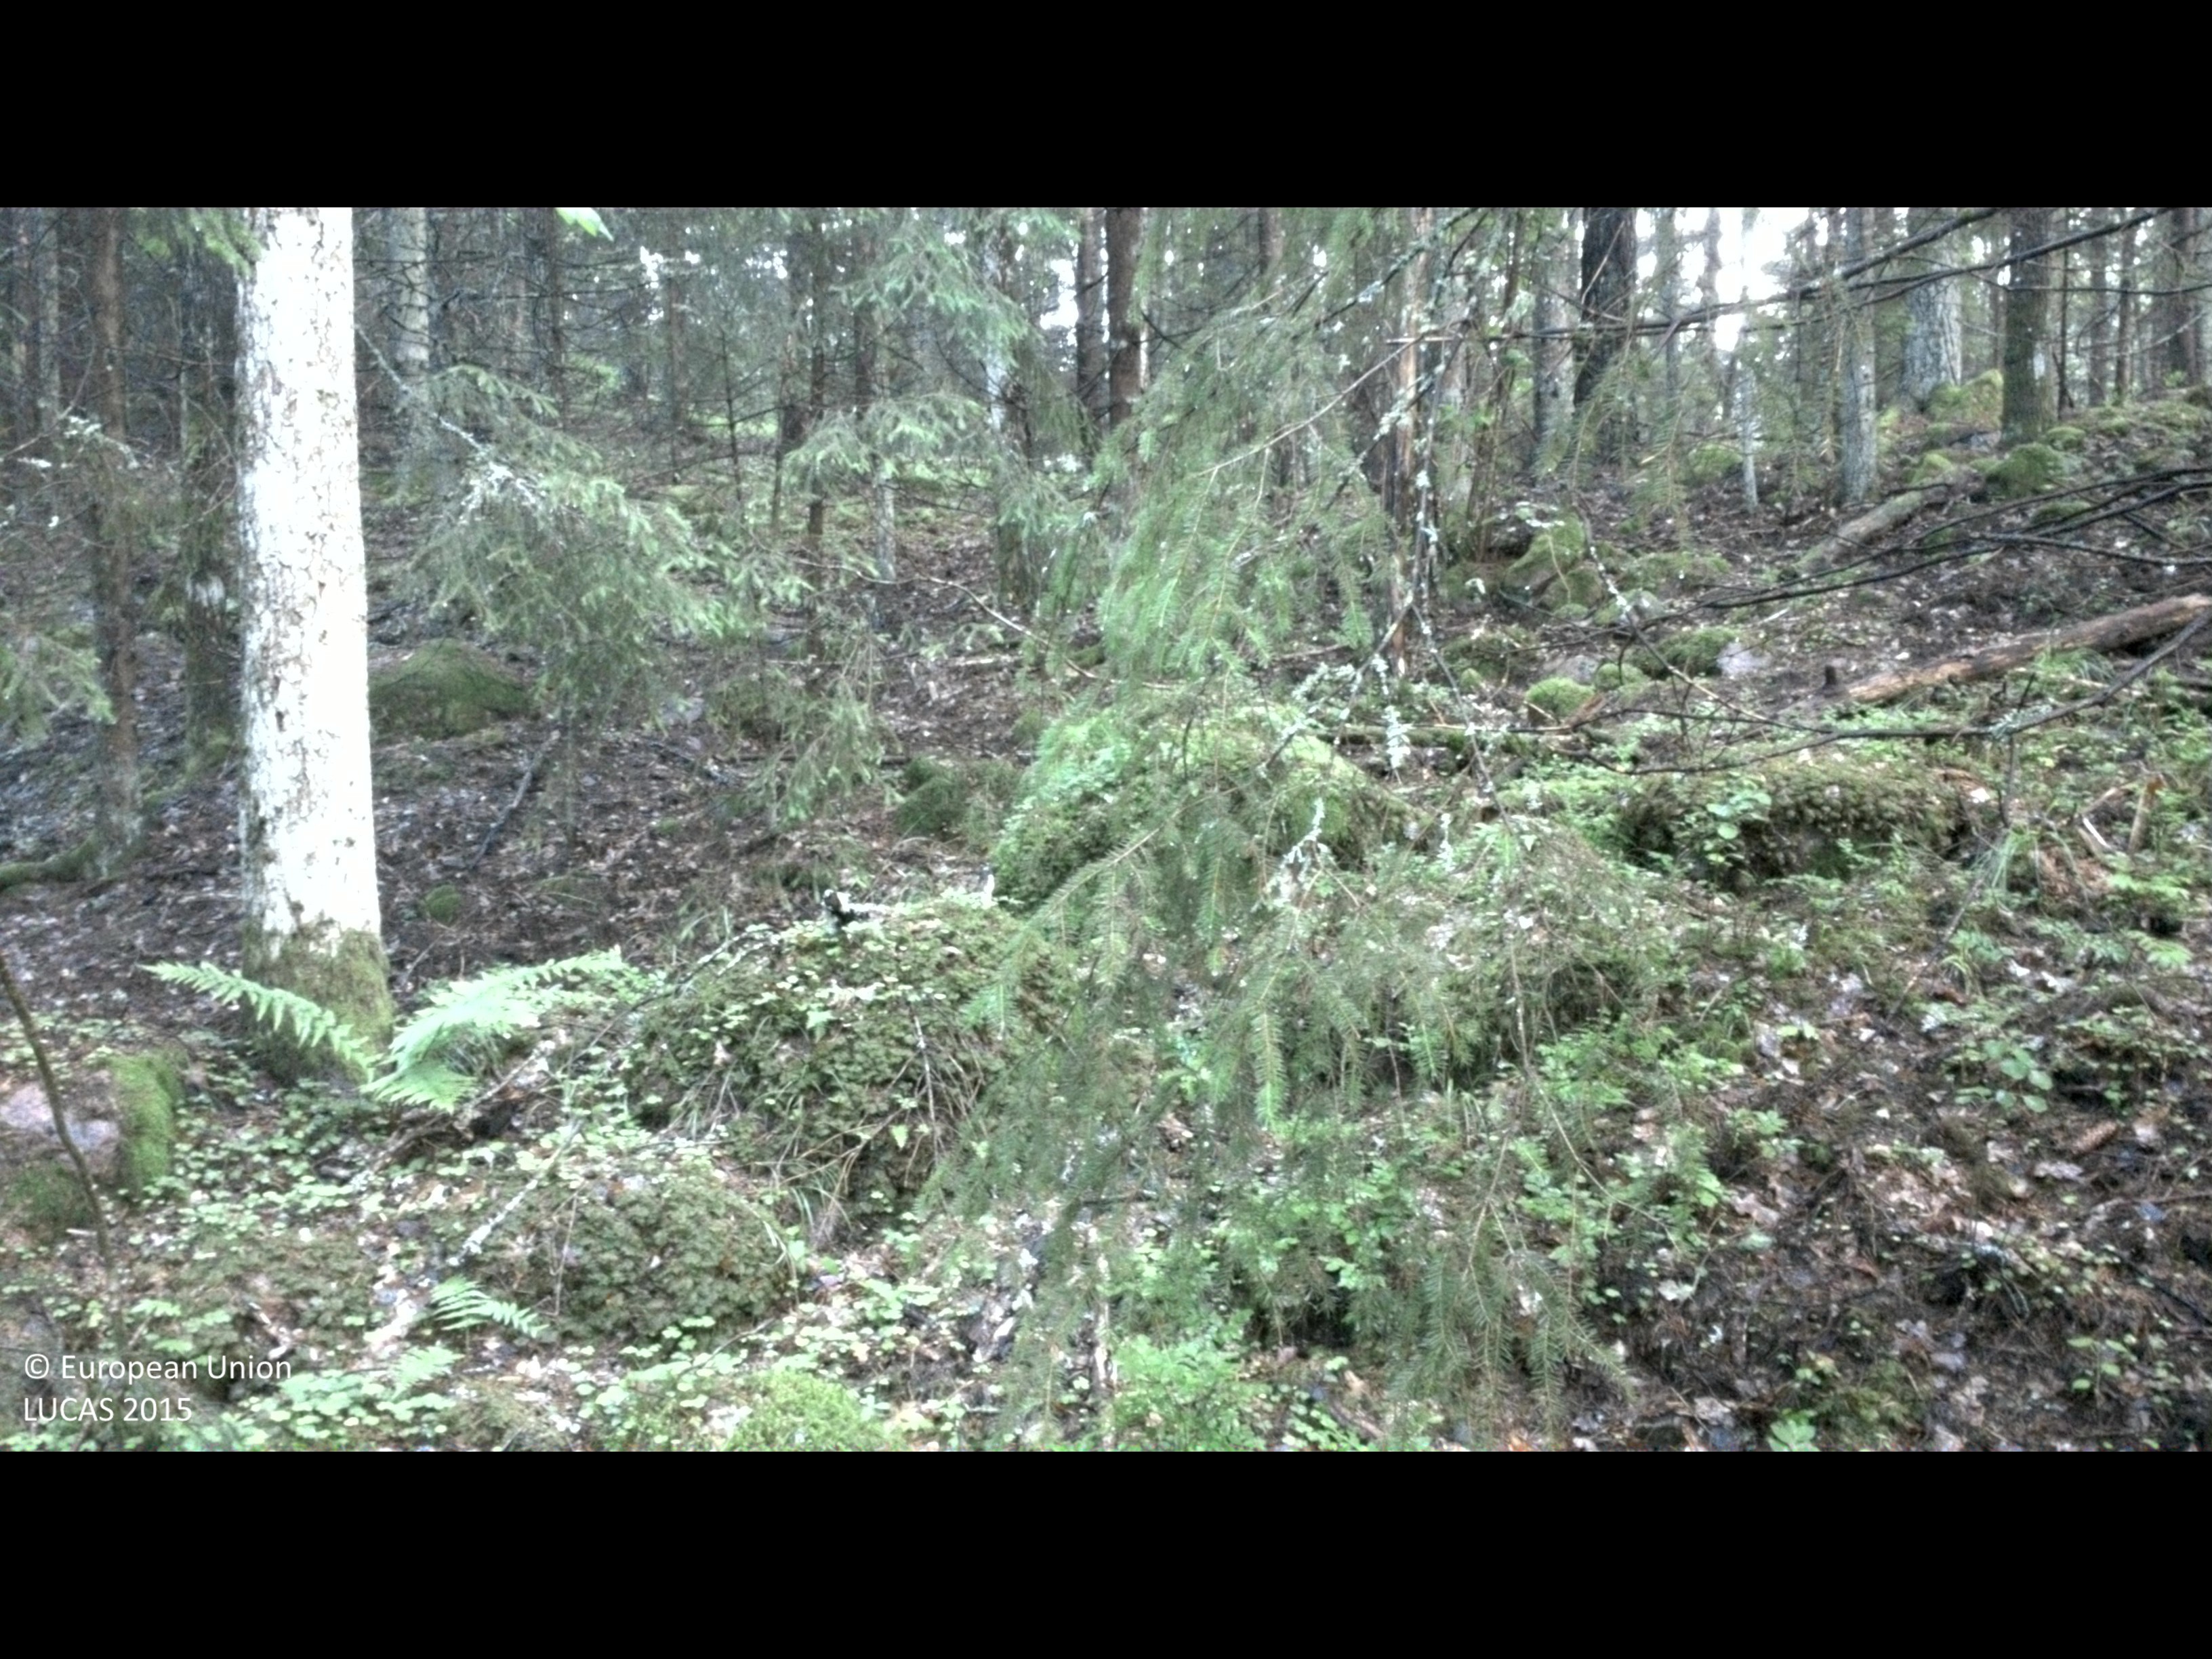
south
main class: Woodland
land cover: Other mixed woodland
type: boreal forest
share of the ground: > 75 %
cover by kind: coniferous forest trees 45 %, broadleaved forest trees 35 %, shrubs 10 %, lichens and mosses 10 %
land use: Forestry
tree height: > 5 m
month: June
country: SE
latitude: 57.9129
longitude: 16.2253
